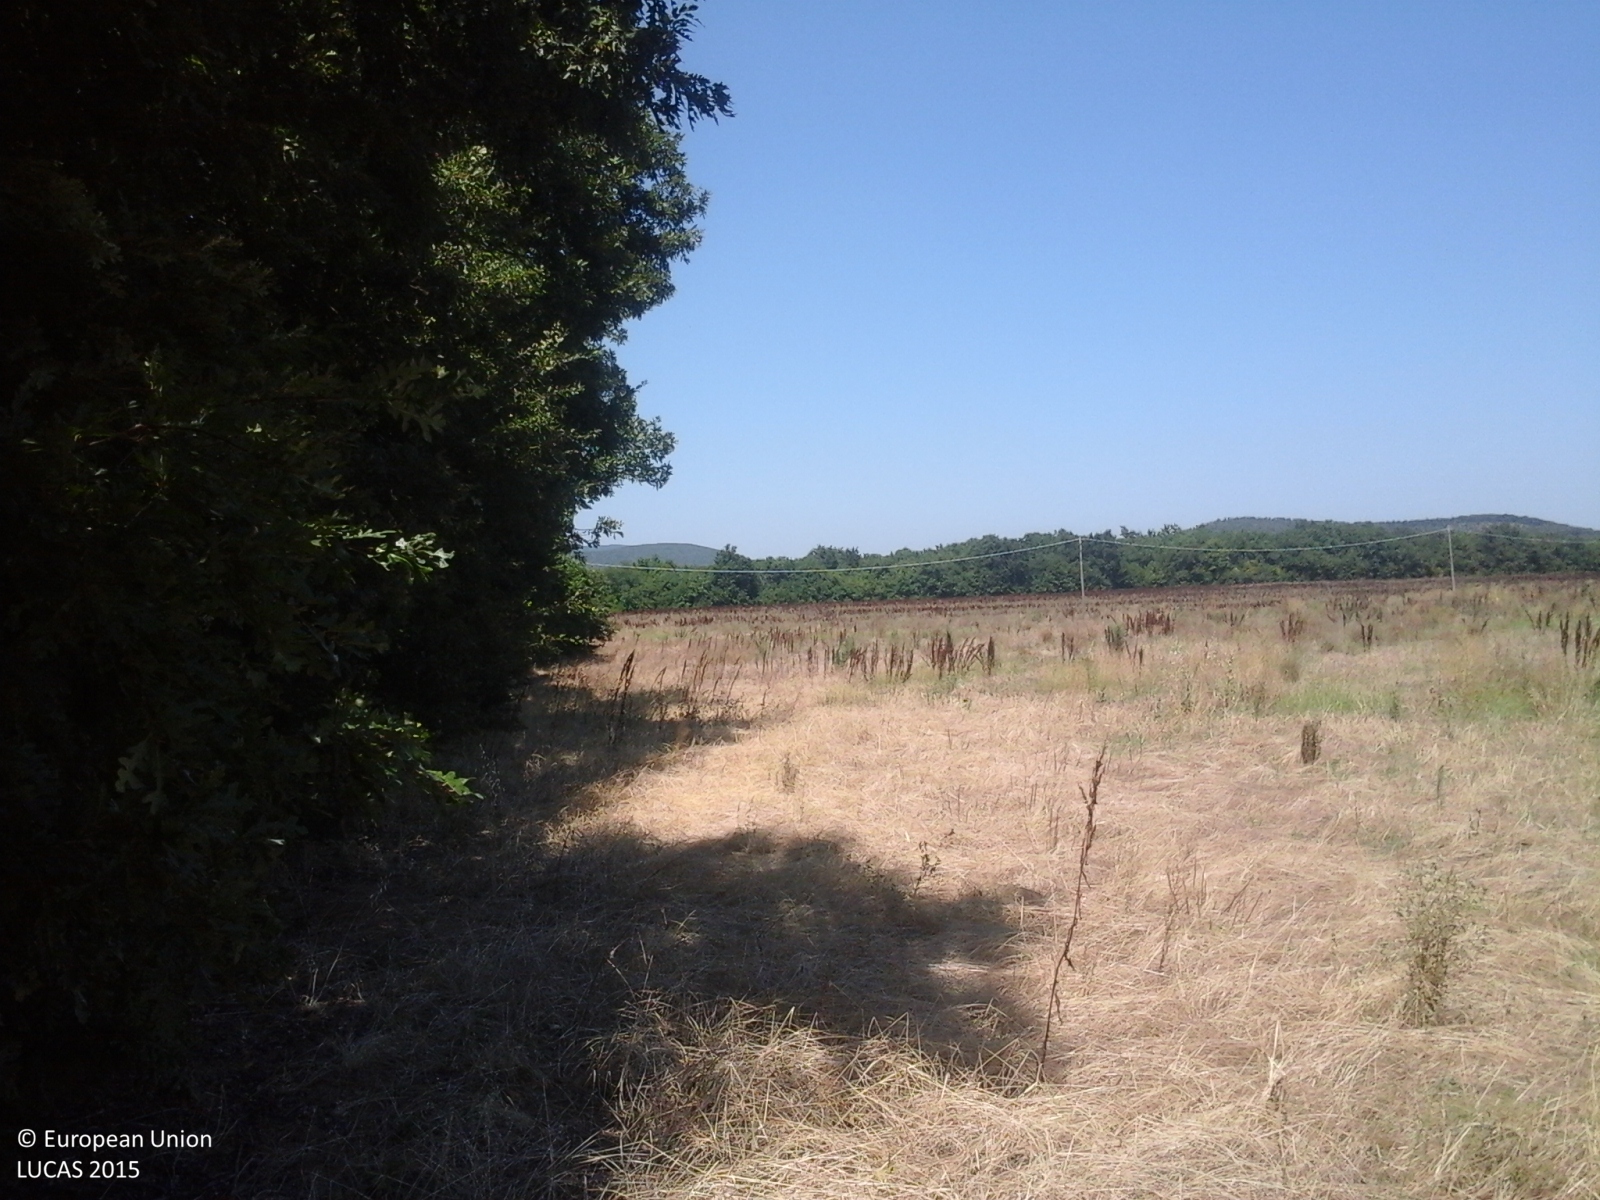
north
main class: Woodland
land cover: Broadleaved woodland
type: thermophilous deciduous forest
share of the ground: > 75 %
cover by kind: broadleaved forest trees 100 %
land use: Forestry
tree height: > 5 m
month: August
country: IT
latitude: 42.5180
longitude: 12.3657
